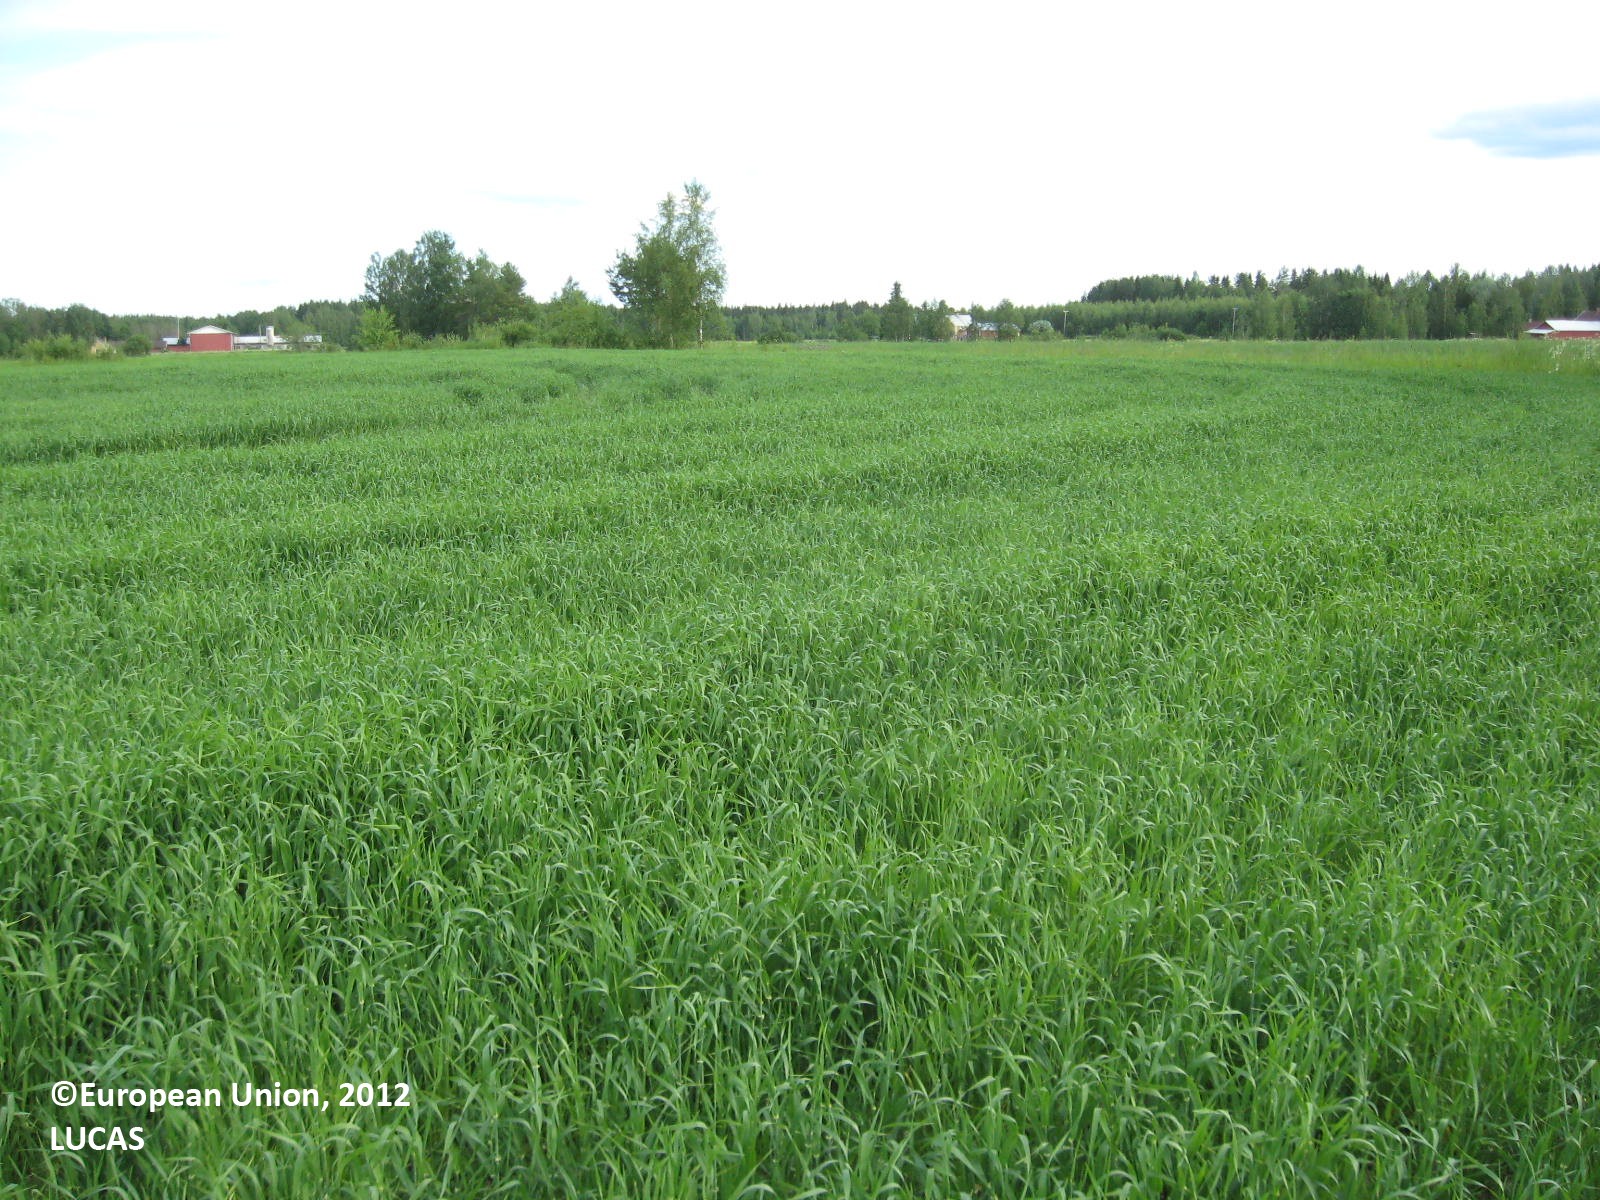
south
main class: Cropland
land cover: Barley
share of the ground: > 75 %
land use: Agriculture (excluding fallow land and kitchen gardens)
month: July
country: FI
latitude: 62.5354
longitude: 22.6321
